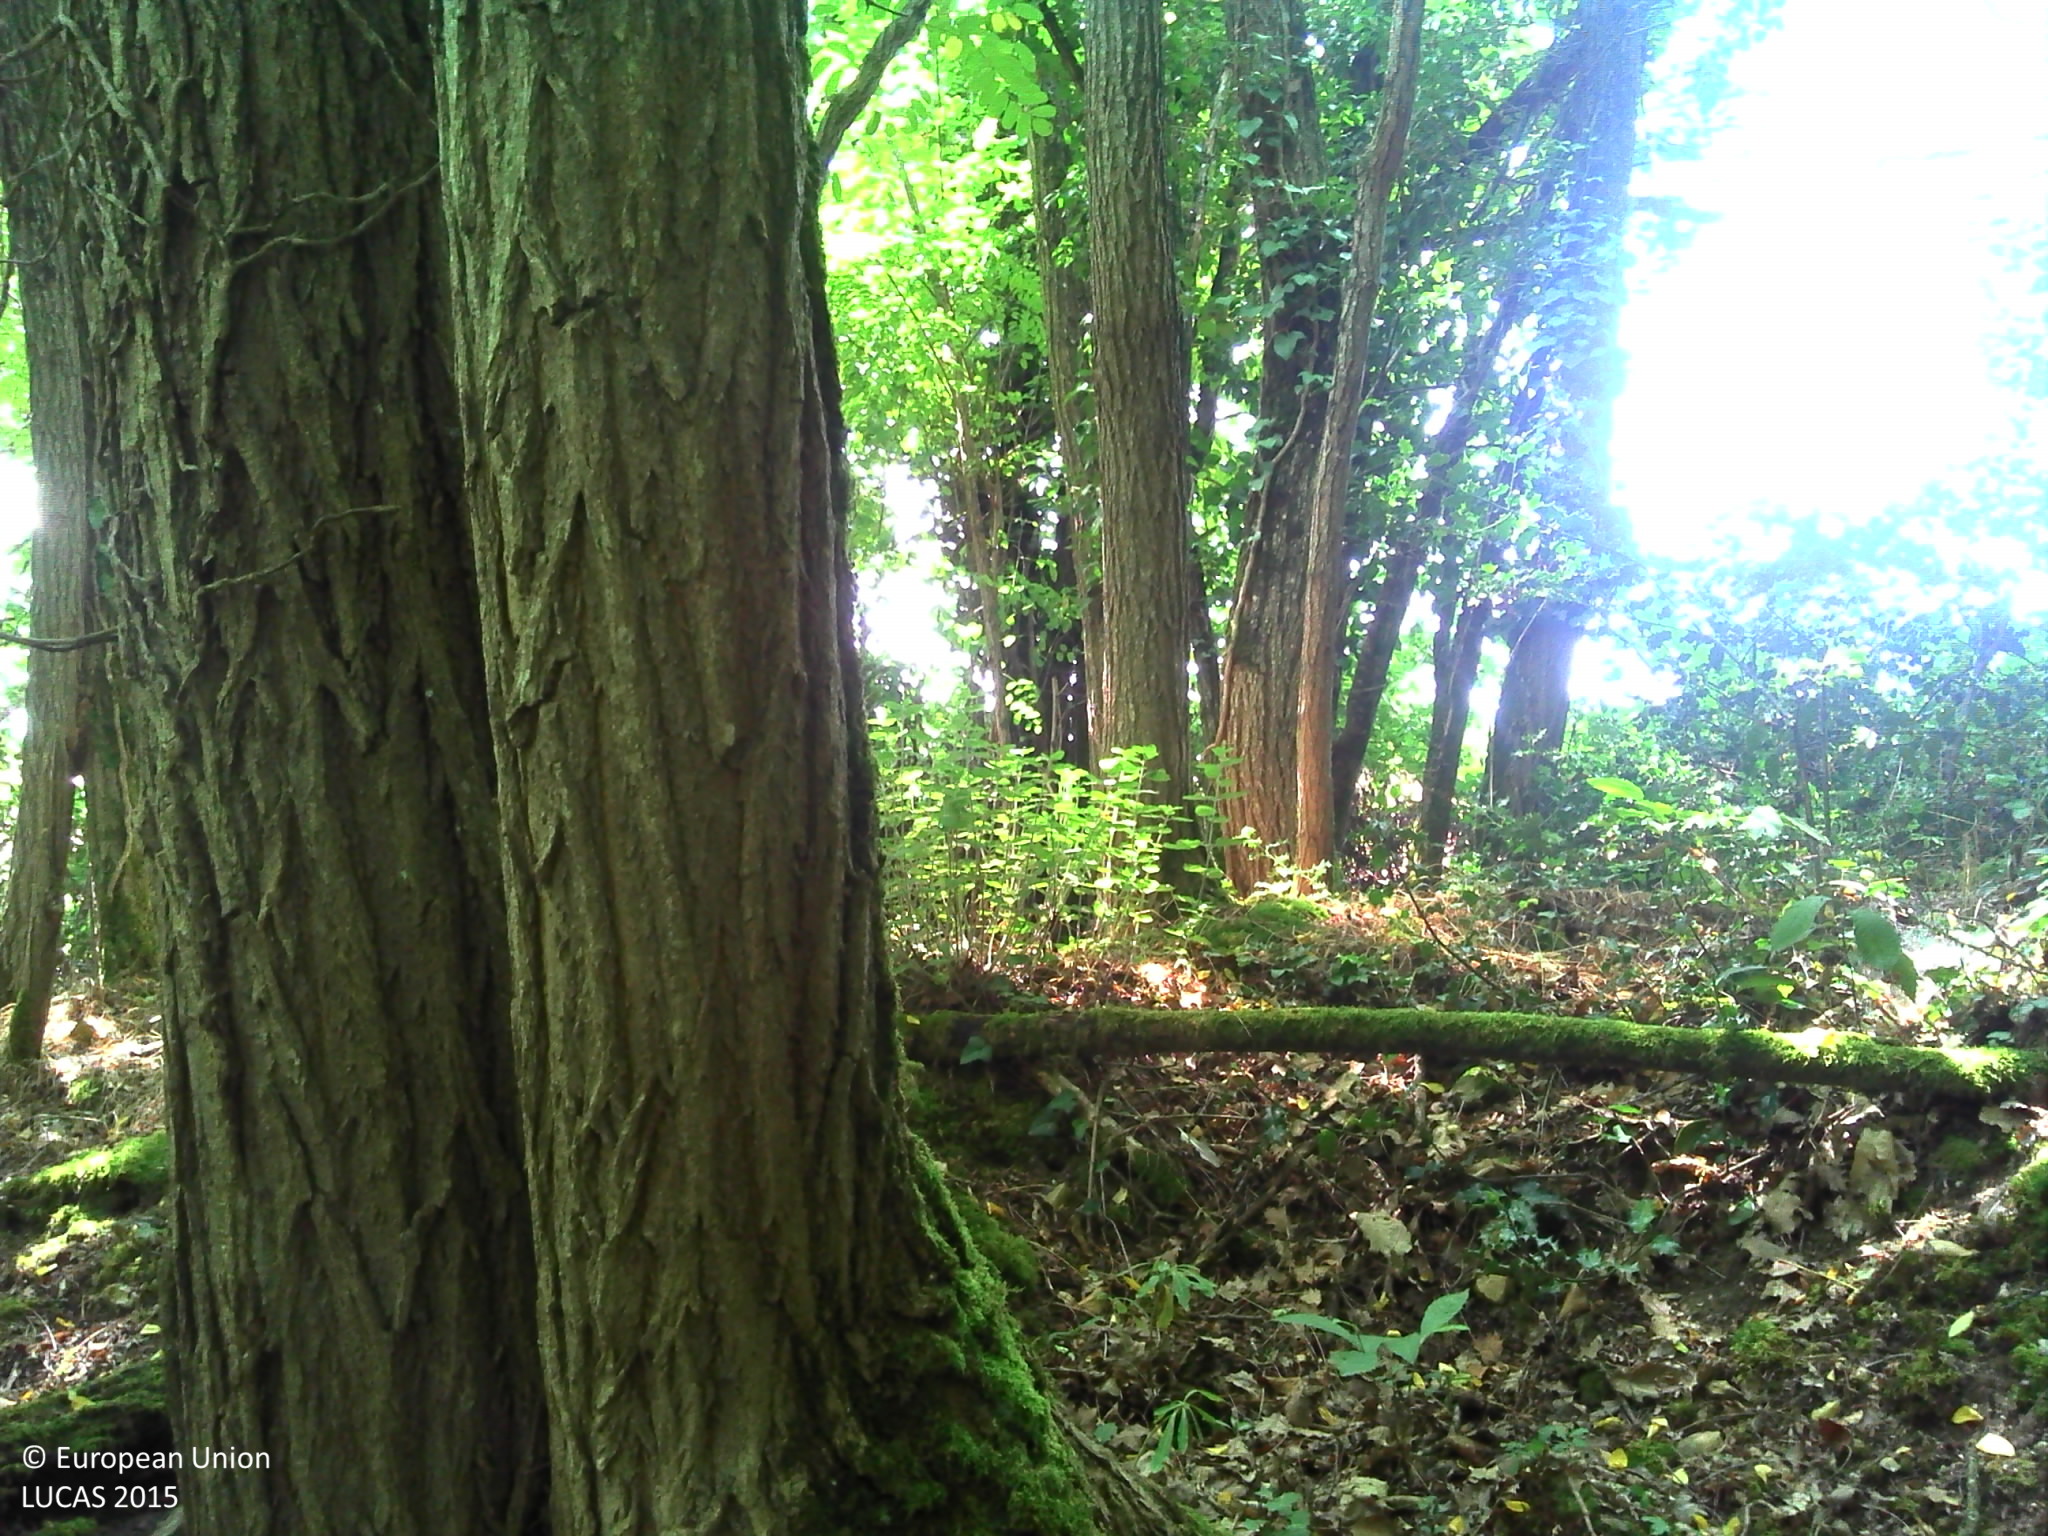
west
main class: Woodland
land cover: Broadleaved woodland
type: mesophytic deciduous forest
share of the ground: > 75 %
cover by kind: broadleaved forest trees 70 %, herbaceous plants 15 %, shrubs 10 %
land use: Forestry
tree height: > 5 m
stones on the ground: < 10 %
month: August
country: FR
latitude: 45.2072
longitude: 0.7597
